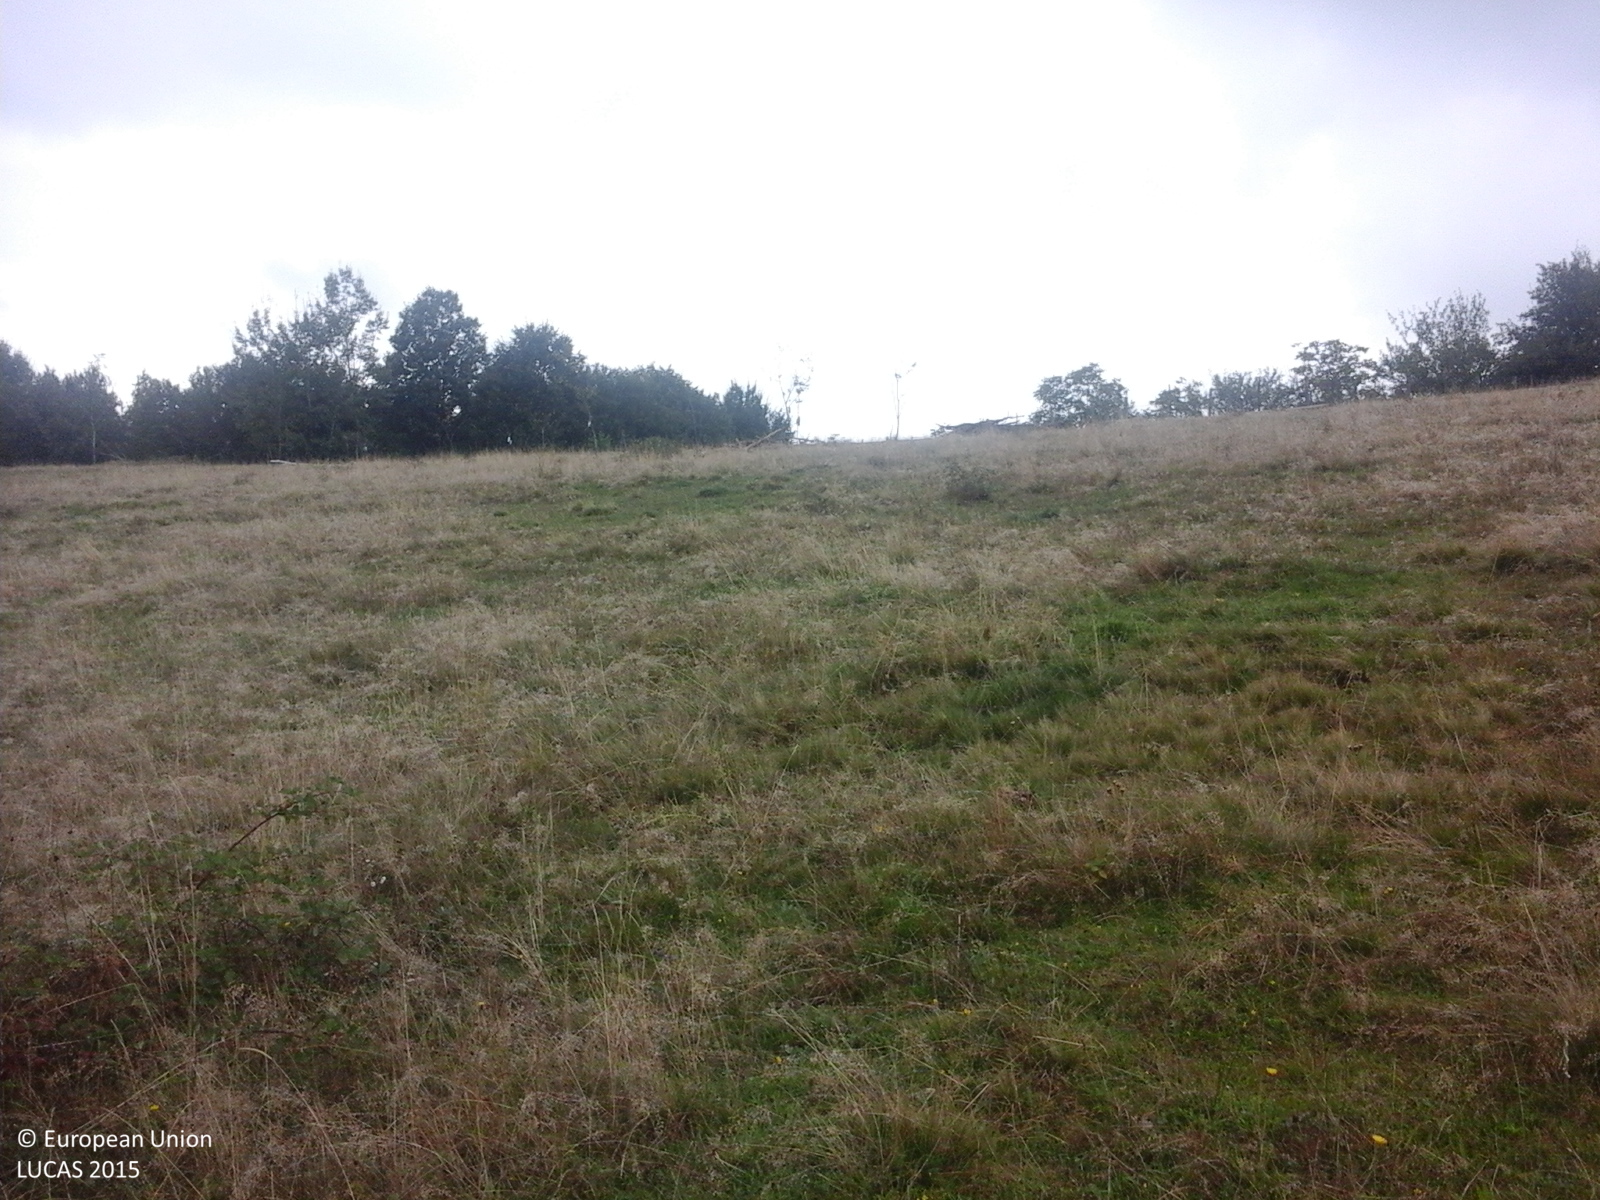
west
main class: Grassland
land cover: Spontaneously vegetated surfaces
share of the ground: > 75 %
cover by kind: herbaceous plants 100 %
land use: Fallow land
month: September
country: RO
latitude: 47.0035
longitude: 22.6163
